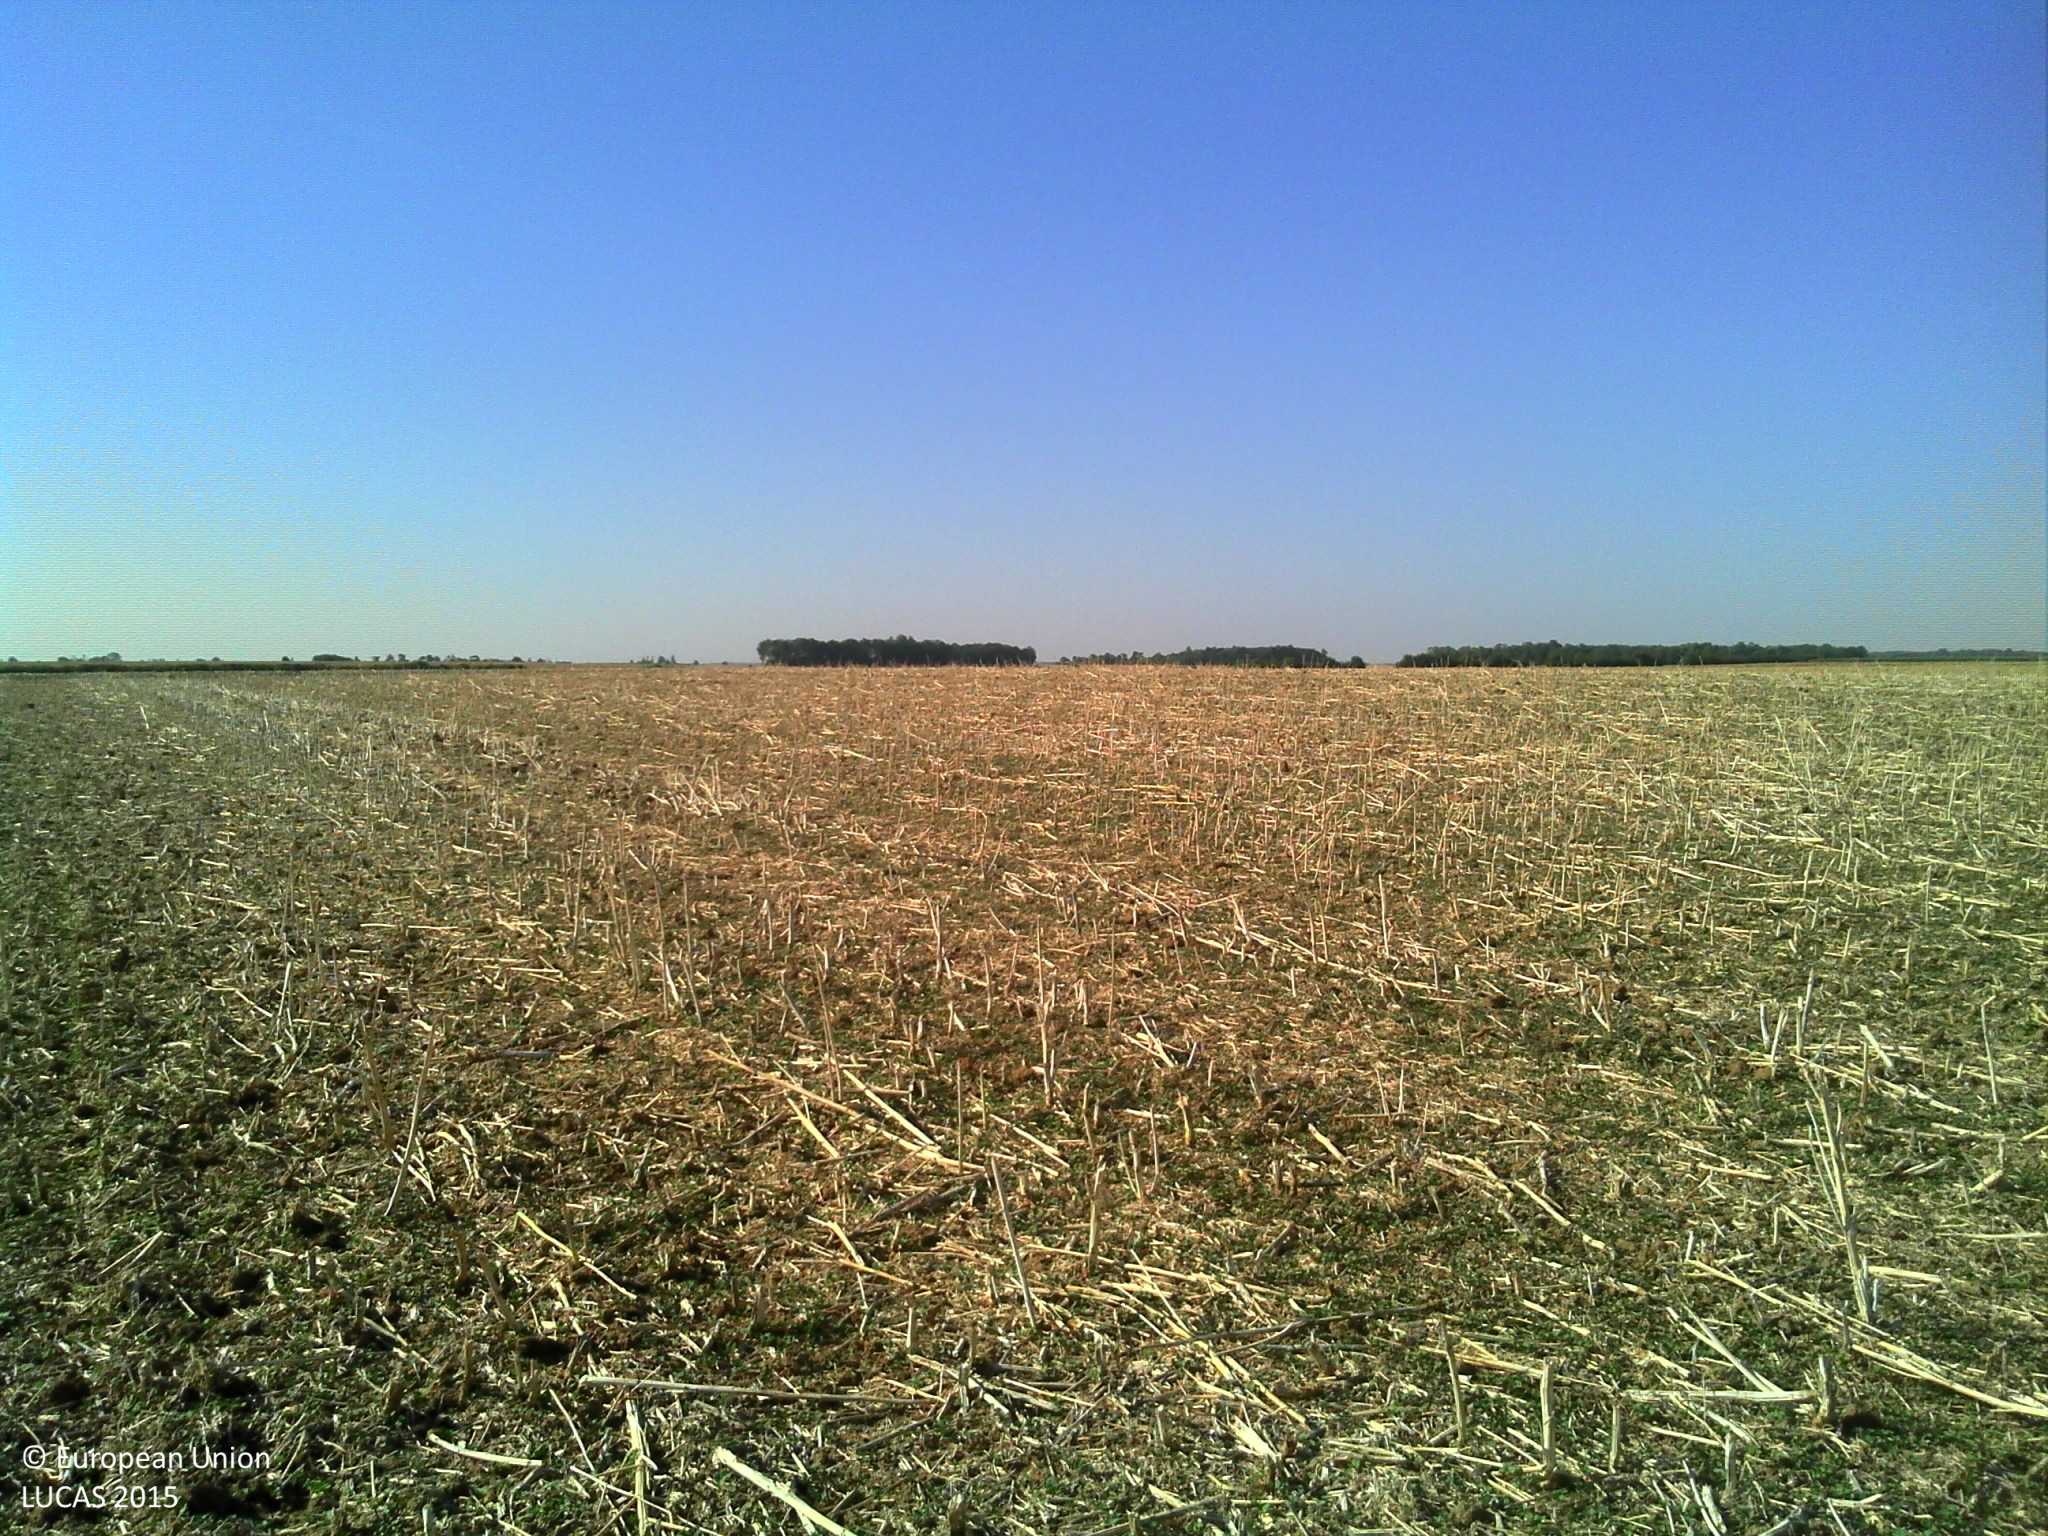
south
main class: Cropland
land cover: Rape and turnip rape
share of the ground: 10 - 25 %
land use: Agriculture (excluding fallow land and kitchen gardens)
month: August
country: FR
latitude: 48.1309
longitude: 1.9926
